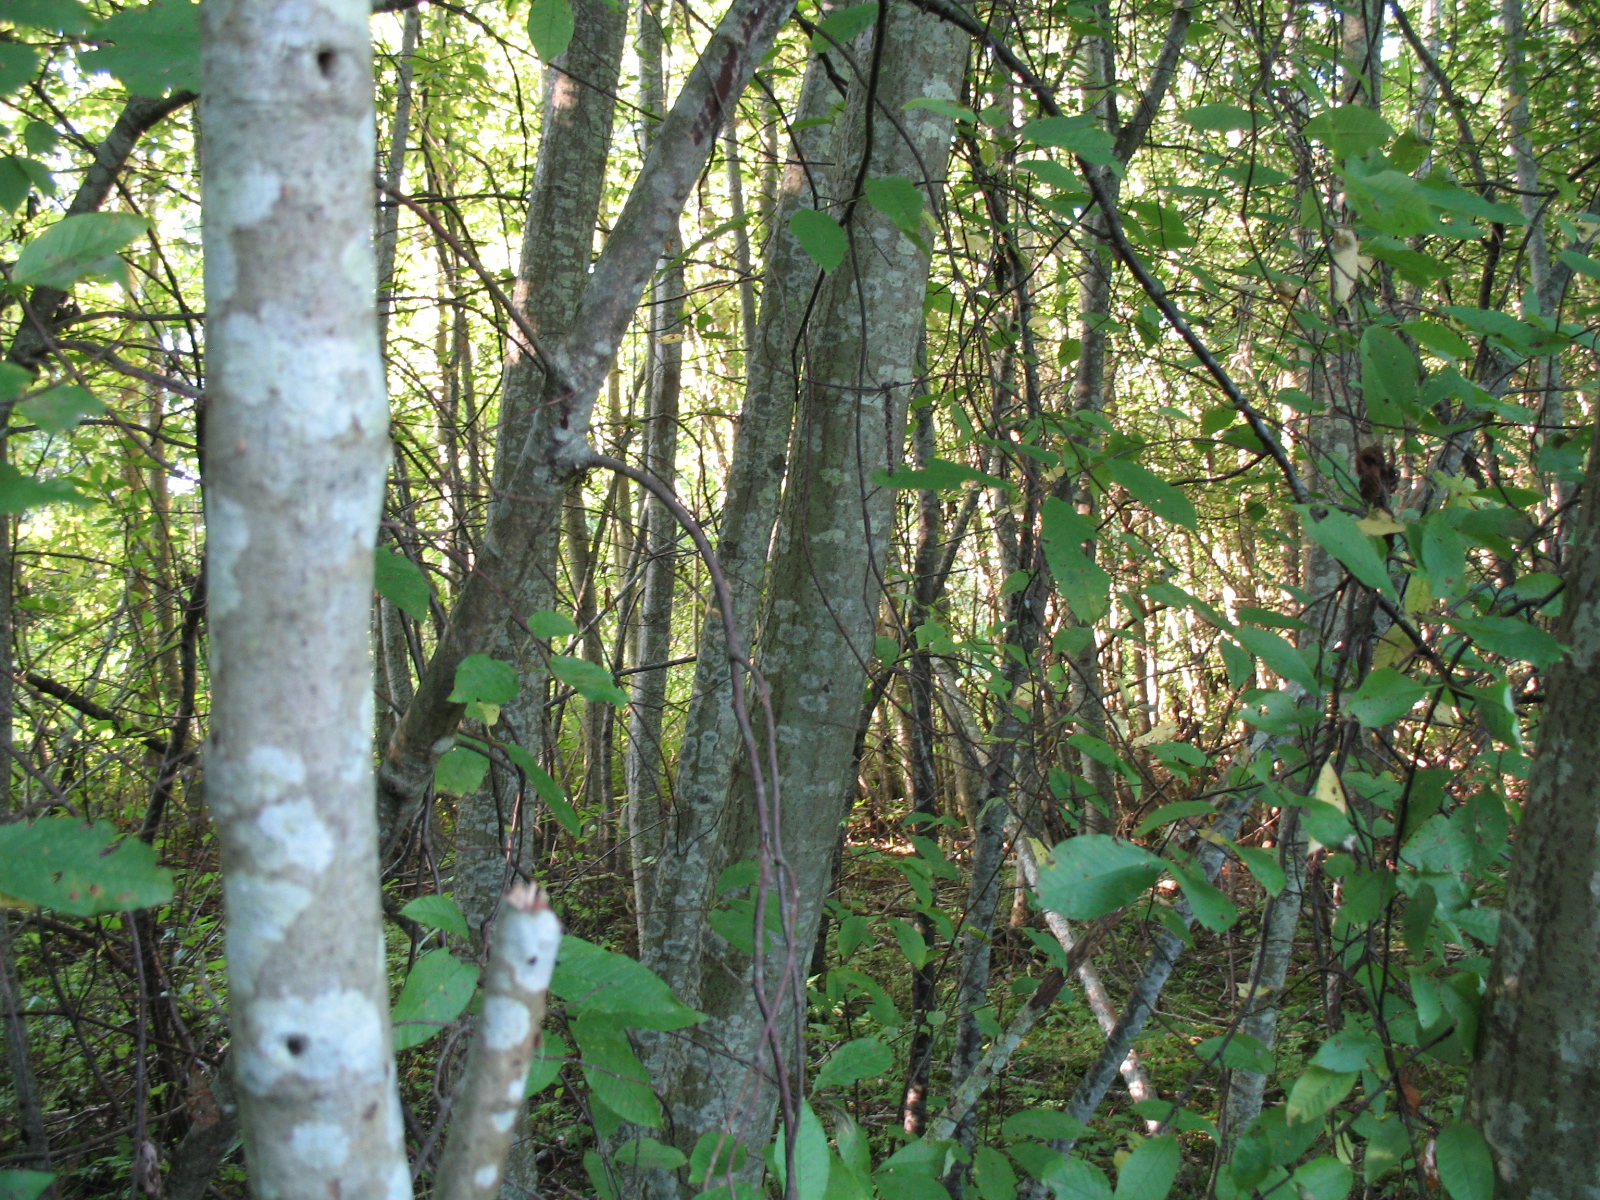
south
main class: Woodland
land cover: Broadleaved woodland
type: non-riverine alder, birch or aspen forest
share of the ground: > 75 %
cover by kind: broadleaved forest trees 90 %, shrubs 5 %, herbaceous plants 5 %
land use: Forestry
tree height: > 5 m
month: August
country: LV
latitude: 56.2506
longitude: 25.4691
